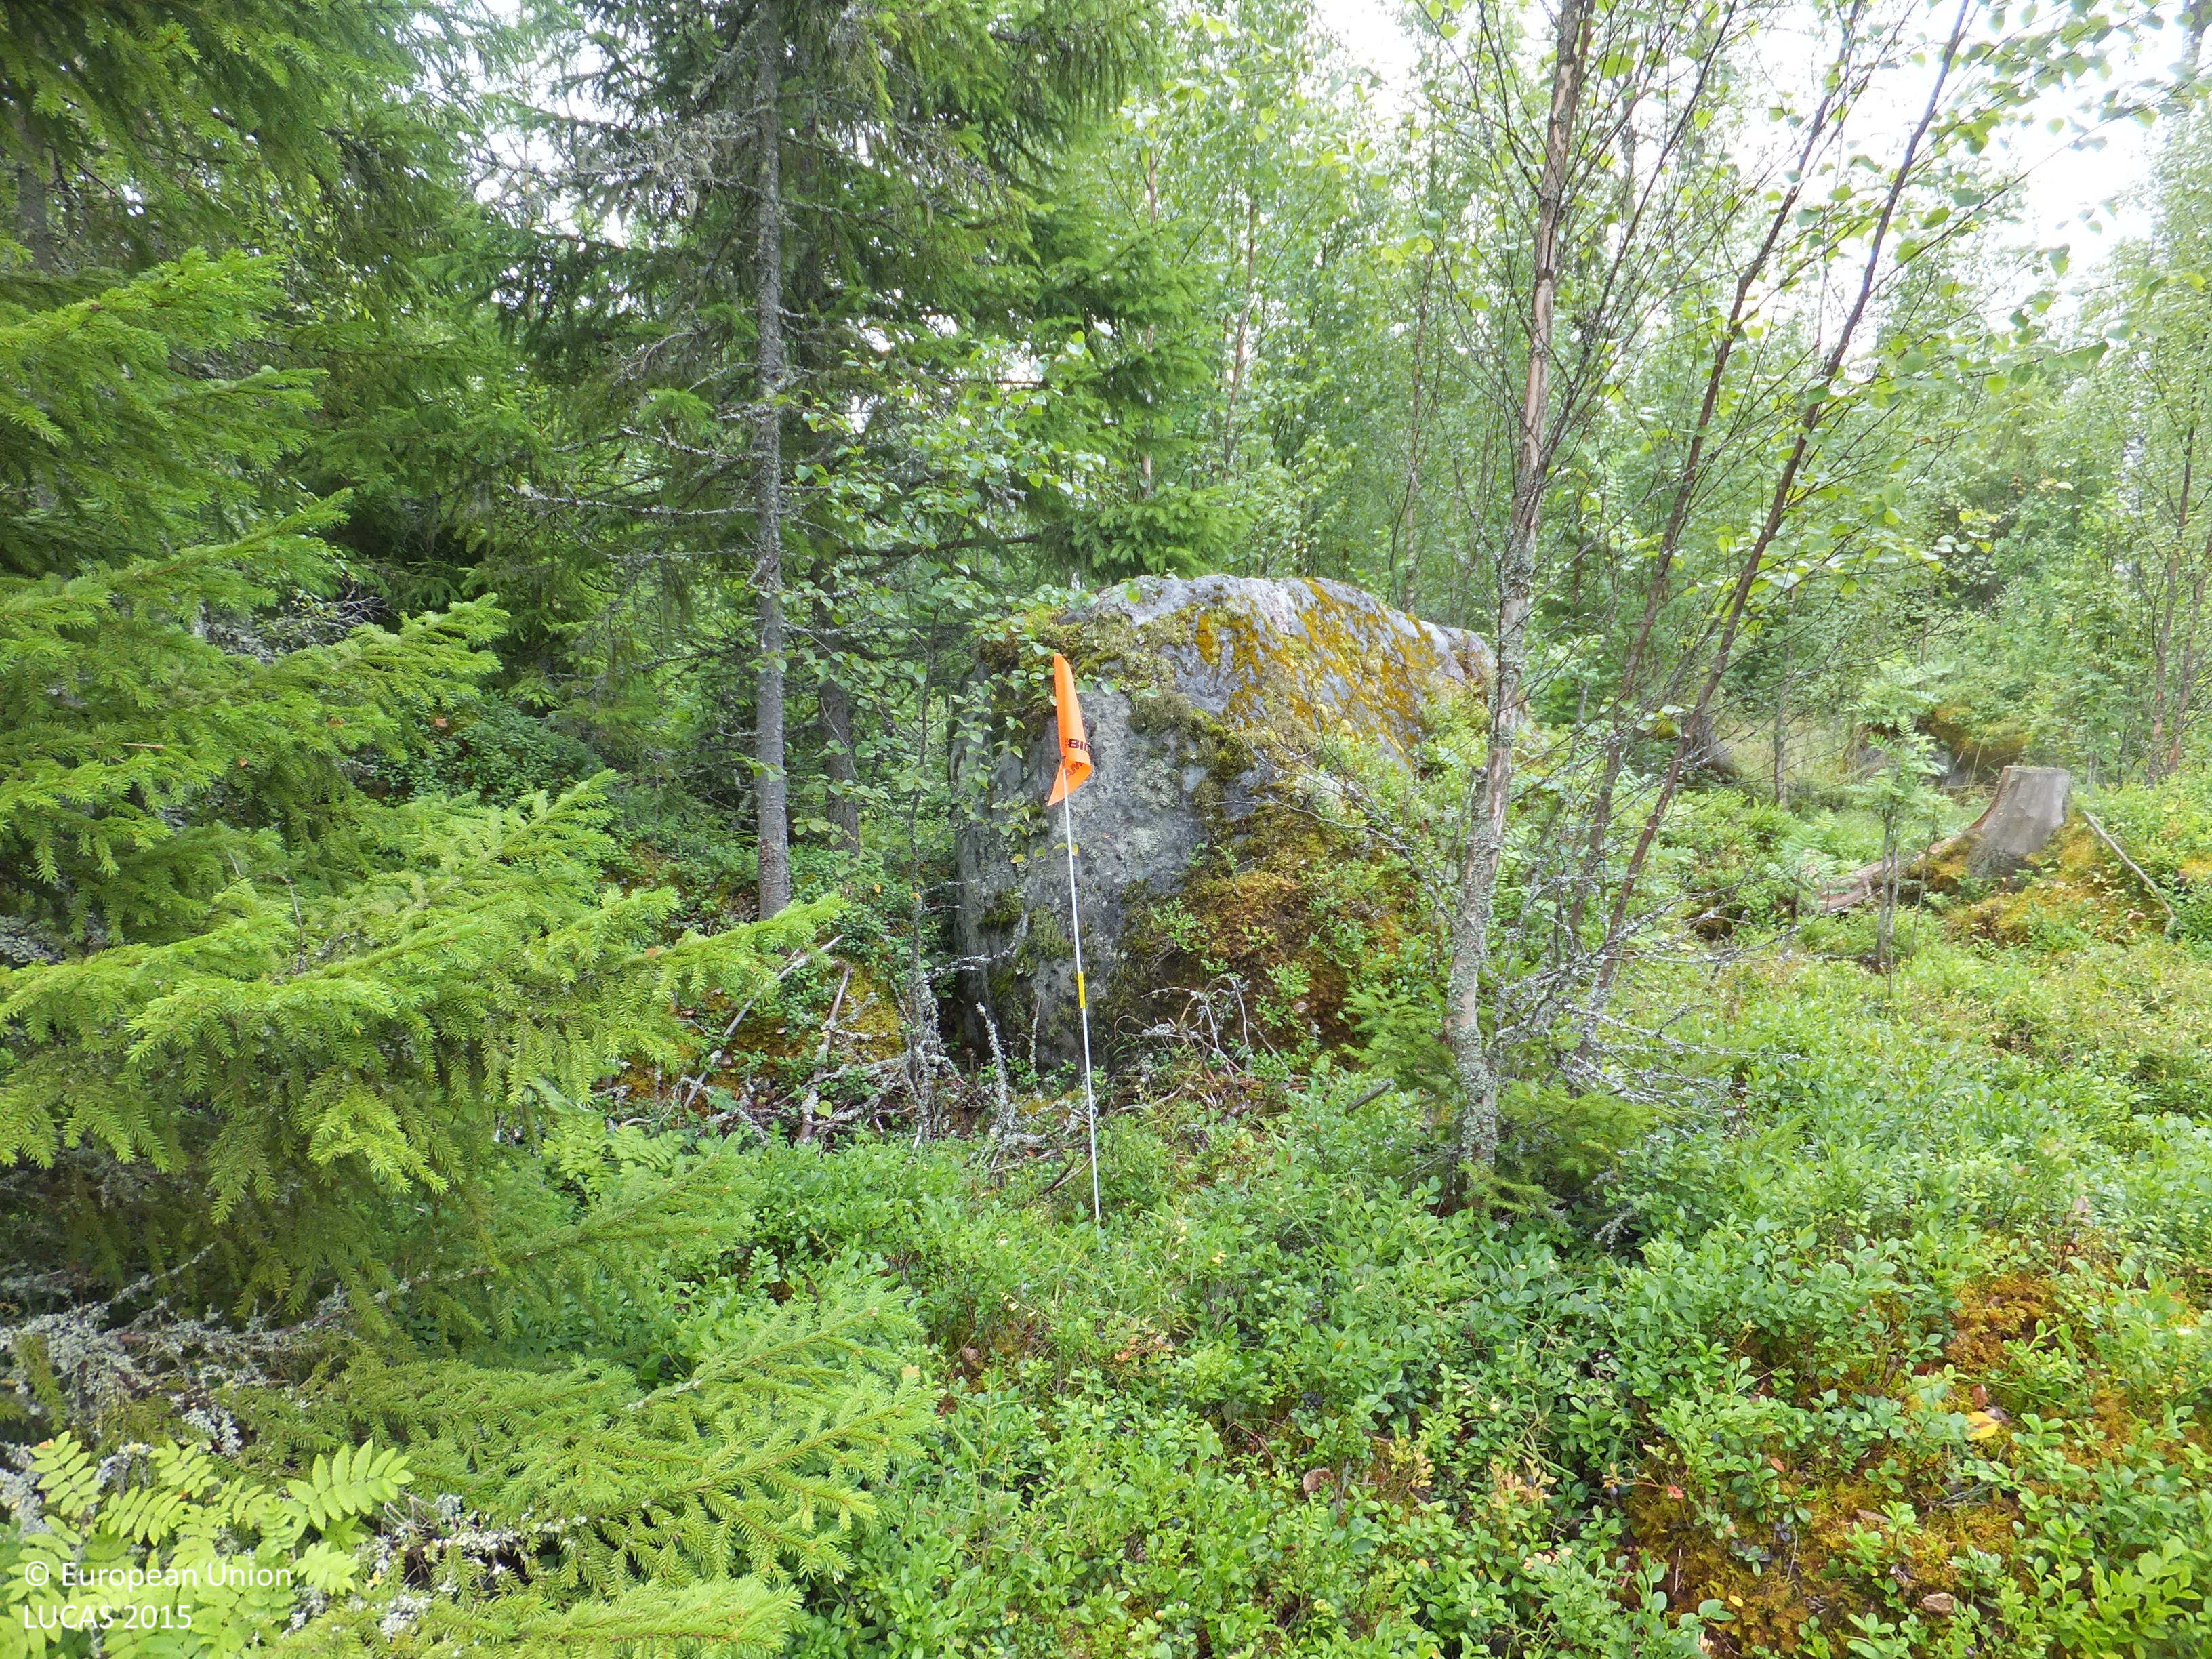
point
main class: Woodland
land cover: Spruce dominated mixed woodland
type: boreal forest
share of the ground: 25 - 50 %
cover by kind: shrubs 30 %, coniferous forest trees 25 %, broadleaved forest trees 20 %, lichens and mosses 10 %, consolidated bare surface 10 %, herbaceous plants 5 %
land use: Forestry
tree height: > 5 m
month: July
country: FI
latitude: 63.0562
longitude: 21.8527
